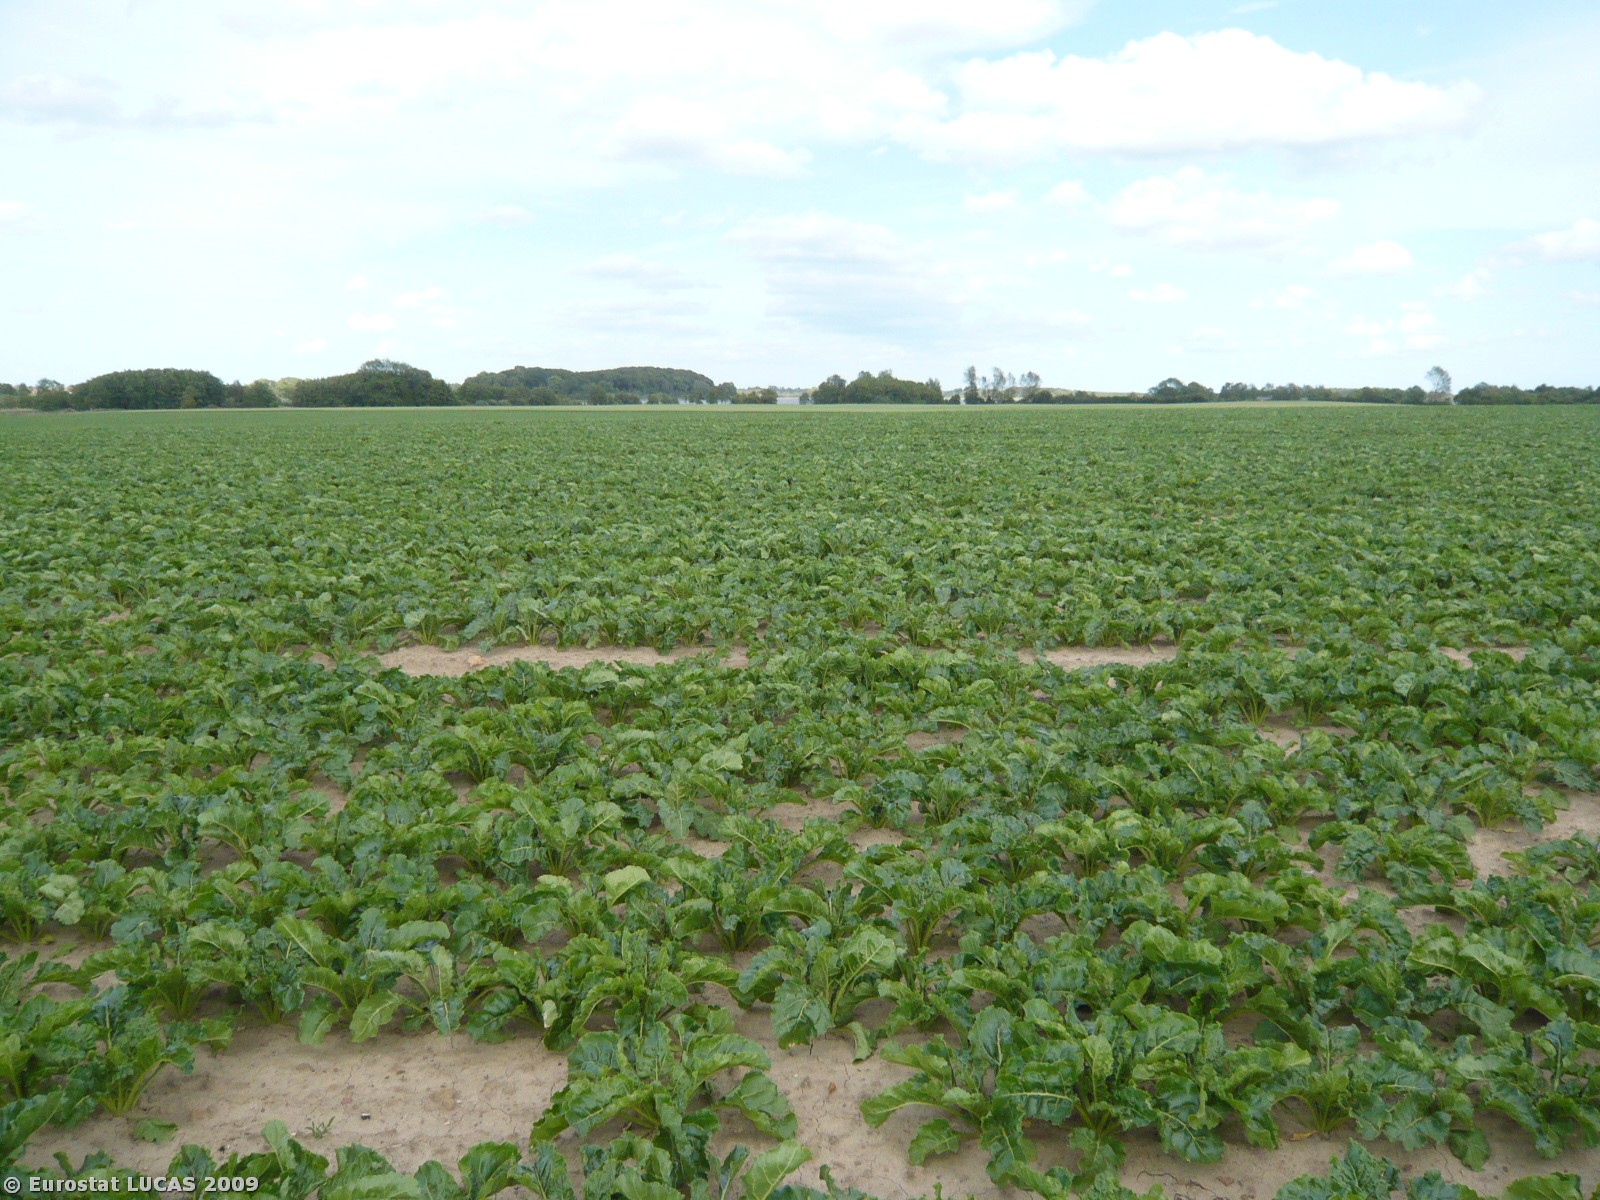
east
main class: Cropland
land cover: Sugar beet
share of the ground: > 75 %
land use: Agriculture (excluding fallow land and kitchen gardens)
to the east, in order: Sugar beet
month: June
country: DK
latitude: 54.7591
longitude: 11.4753
